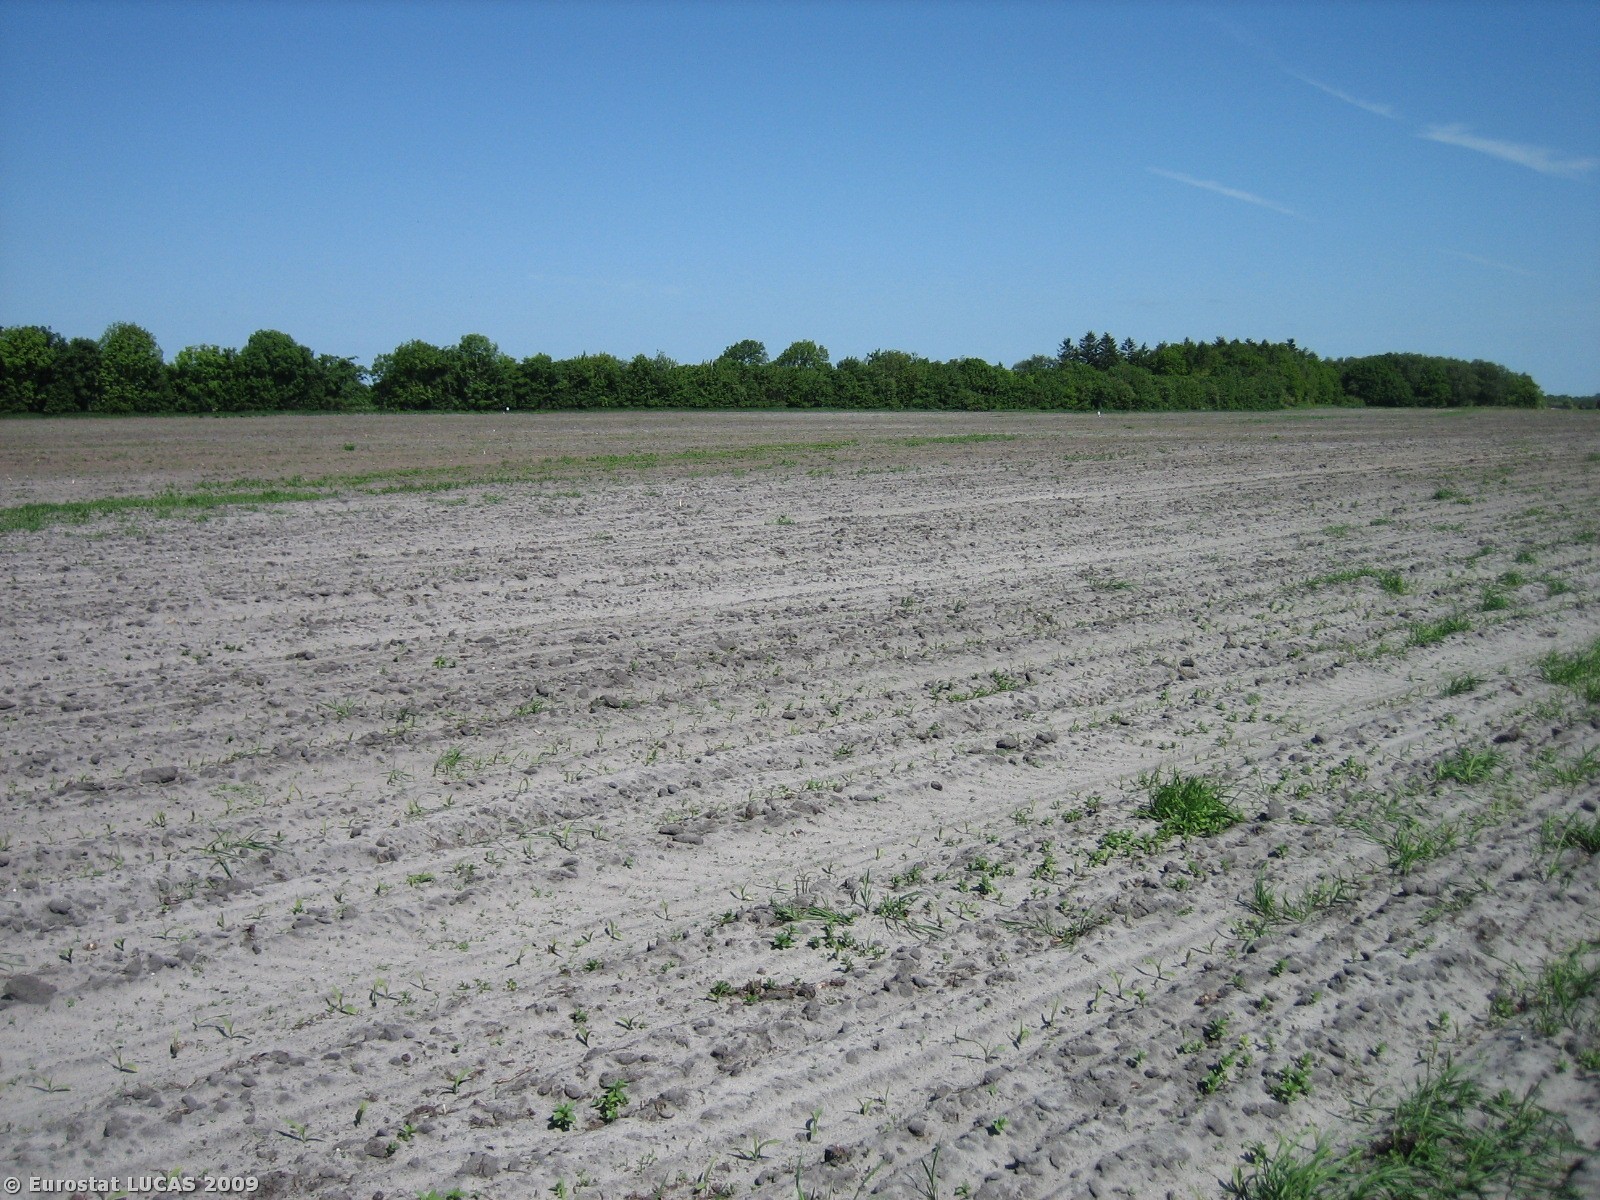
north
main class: Cropland
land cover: Maize
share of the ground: < 10 %
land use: Agriculture (excluding fallow land and kitchen gardens)
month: May
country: DK
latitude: 55.9316
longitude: 8.9287
